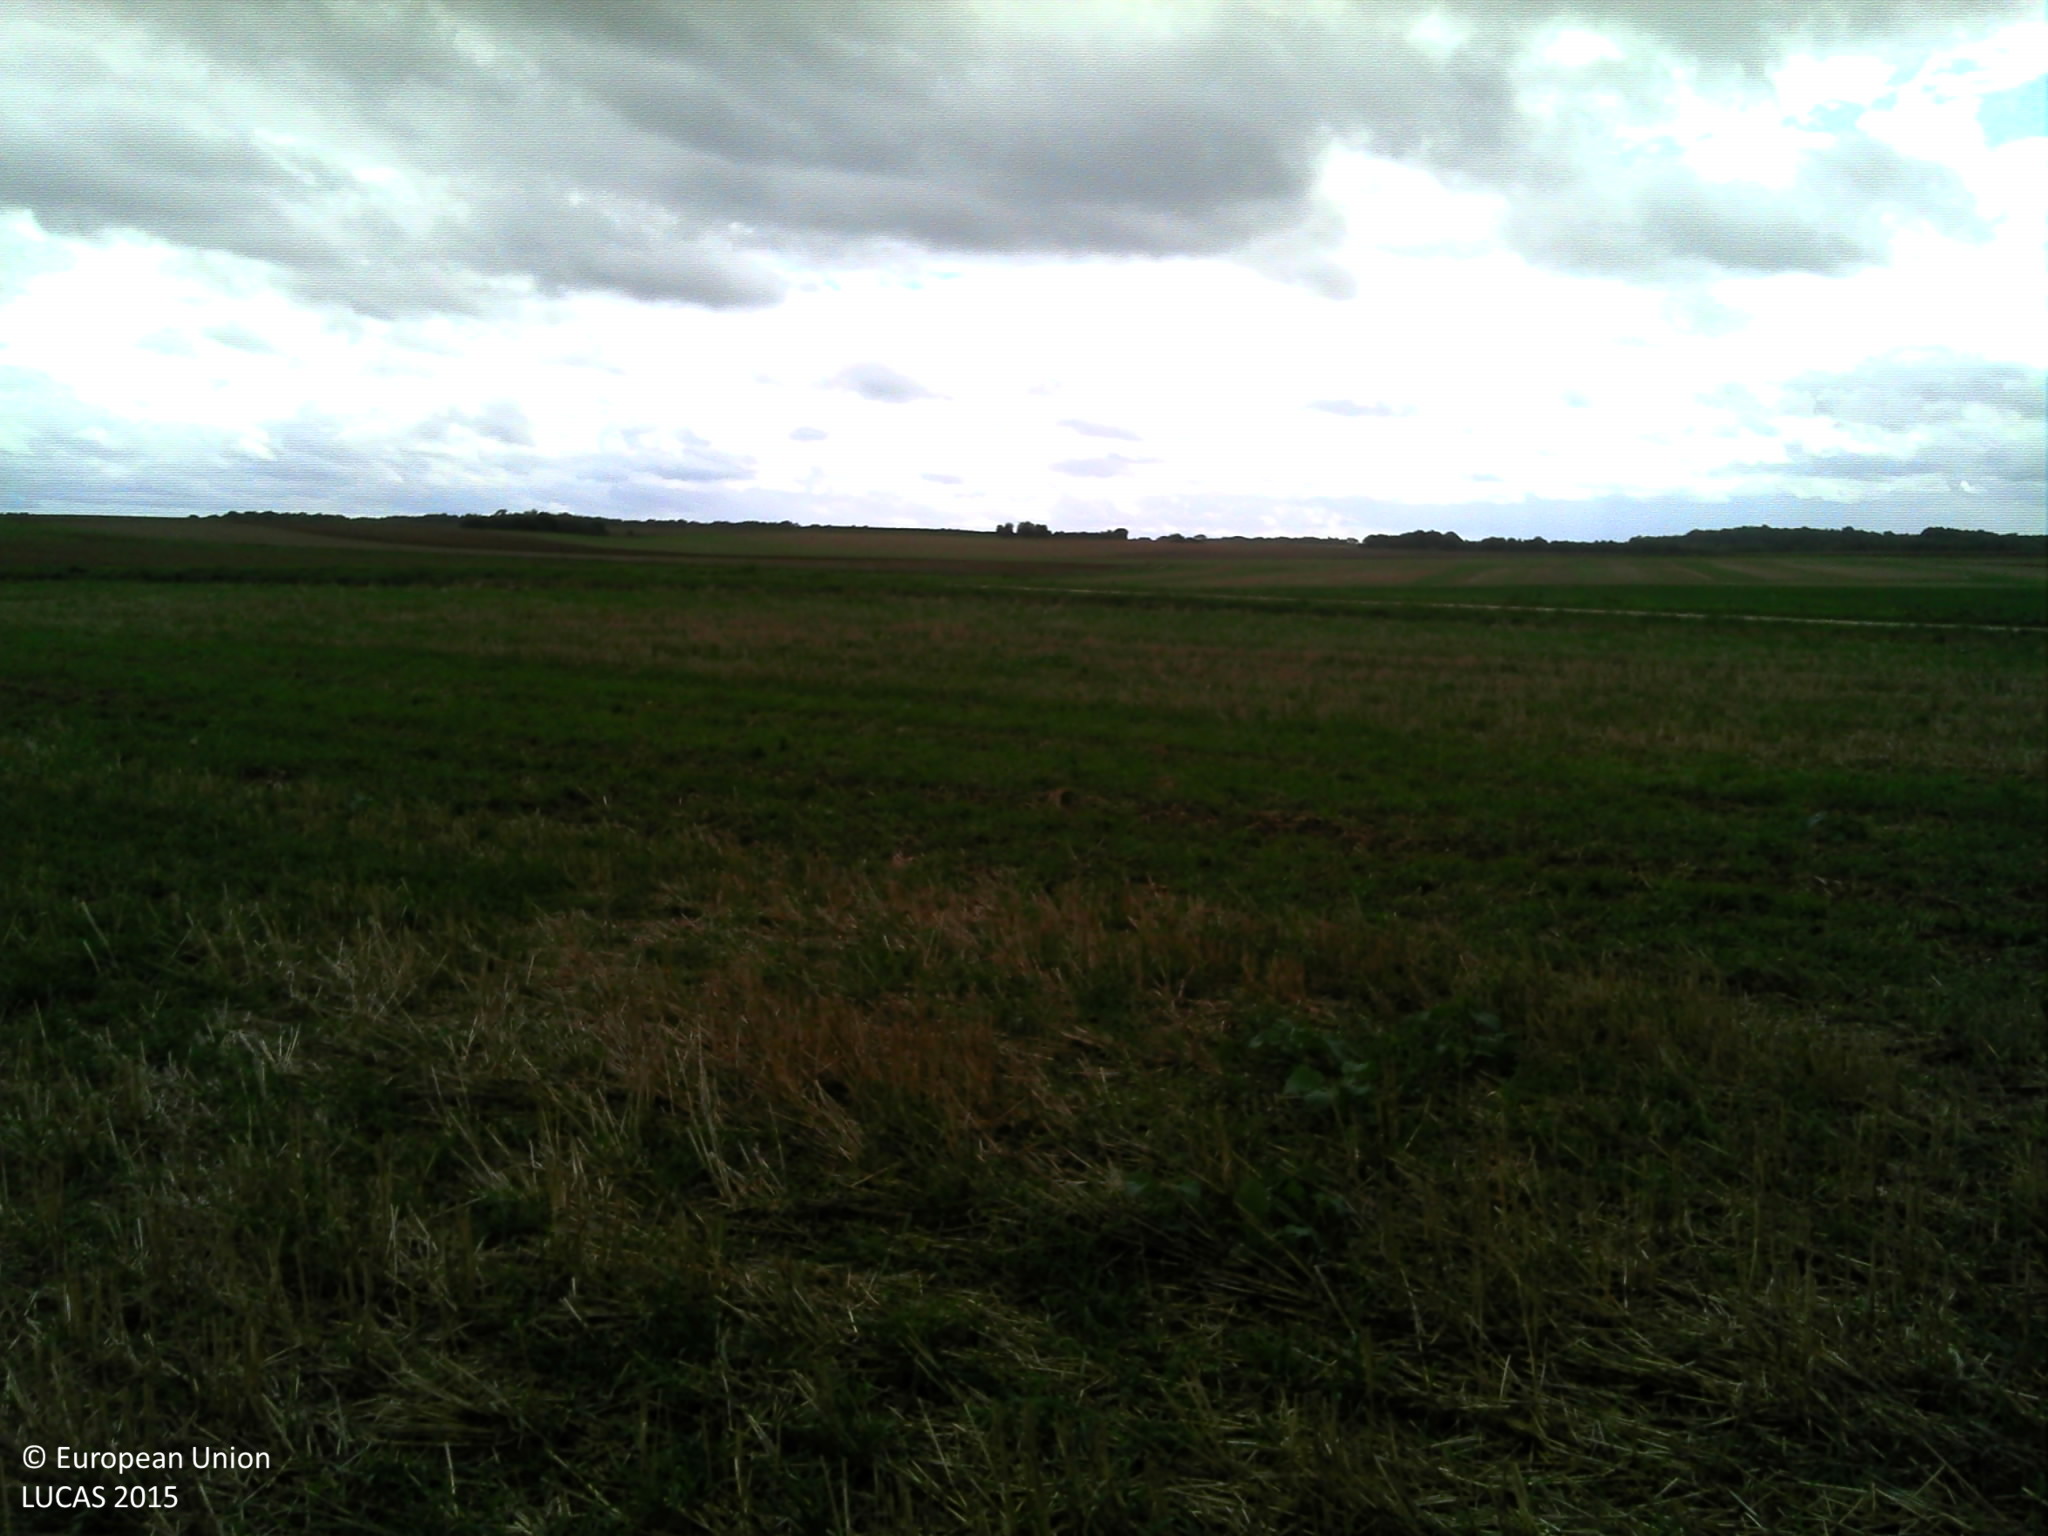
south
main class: Cropland
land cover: Common wheat
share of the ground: 25 - 50 %
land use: Agriculture (excluding fallow land and kitchen gardens)
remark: Harvested field
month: September
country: FR
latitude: 47.7142
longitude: 4.2798
